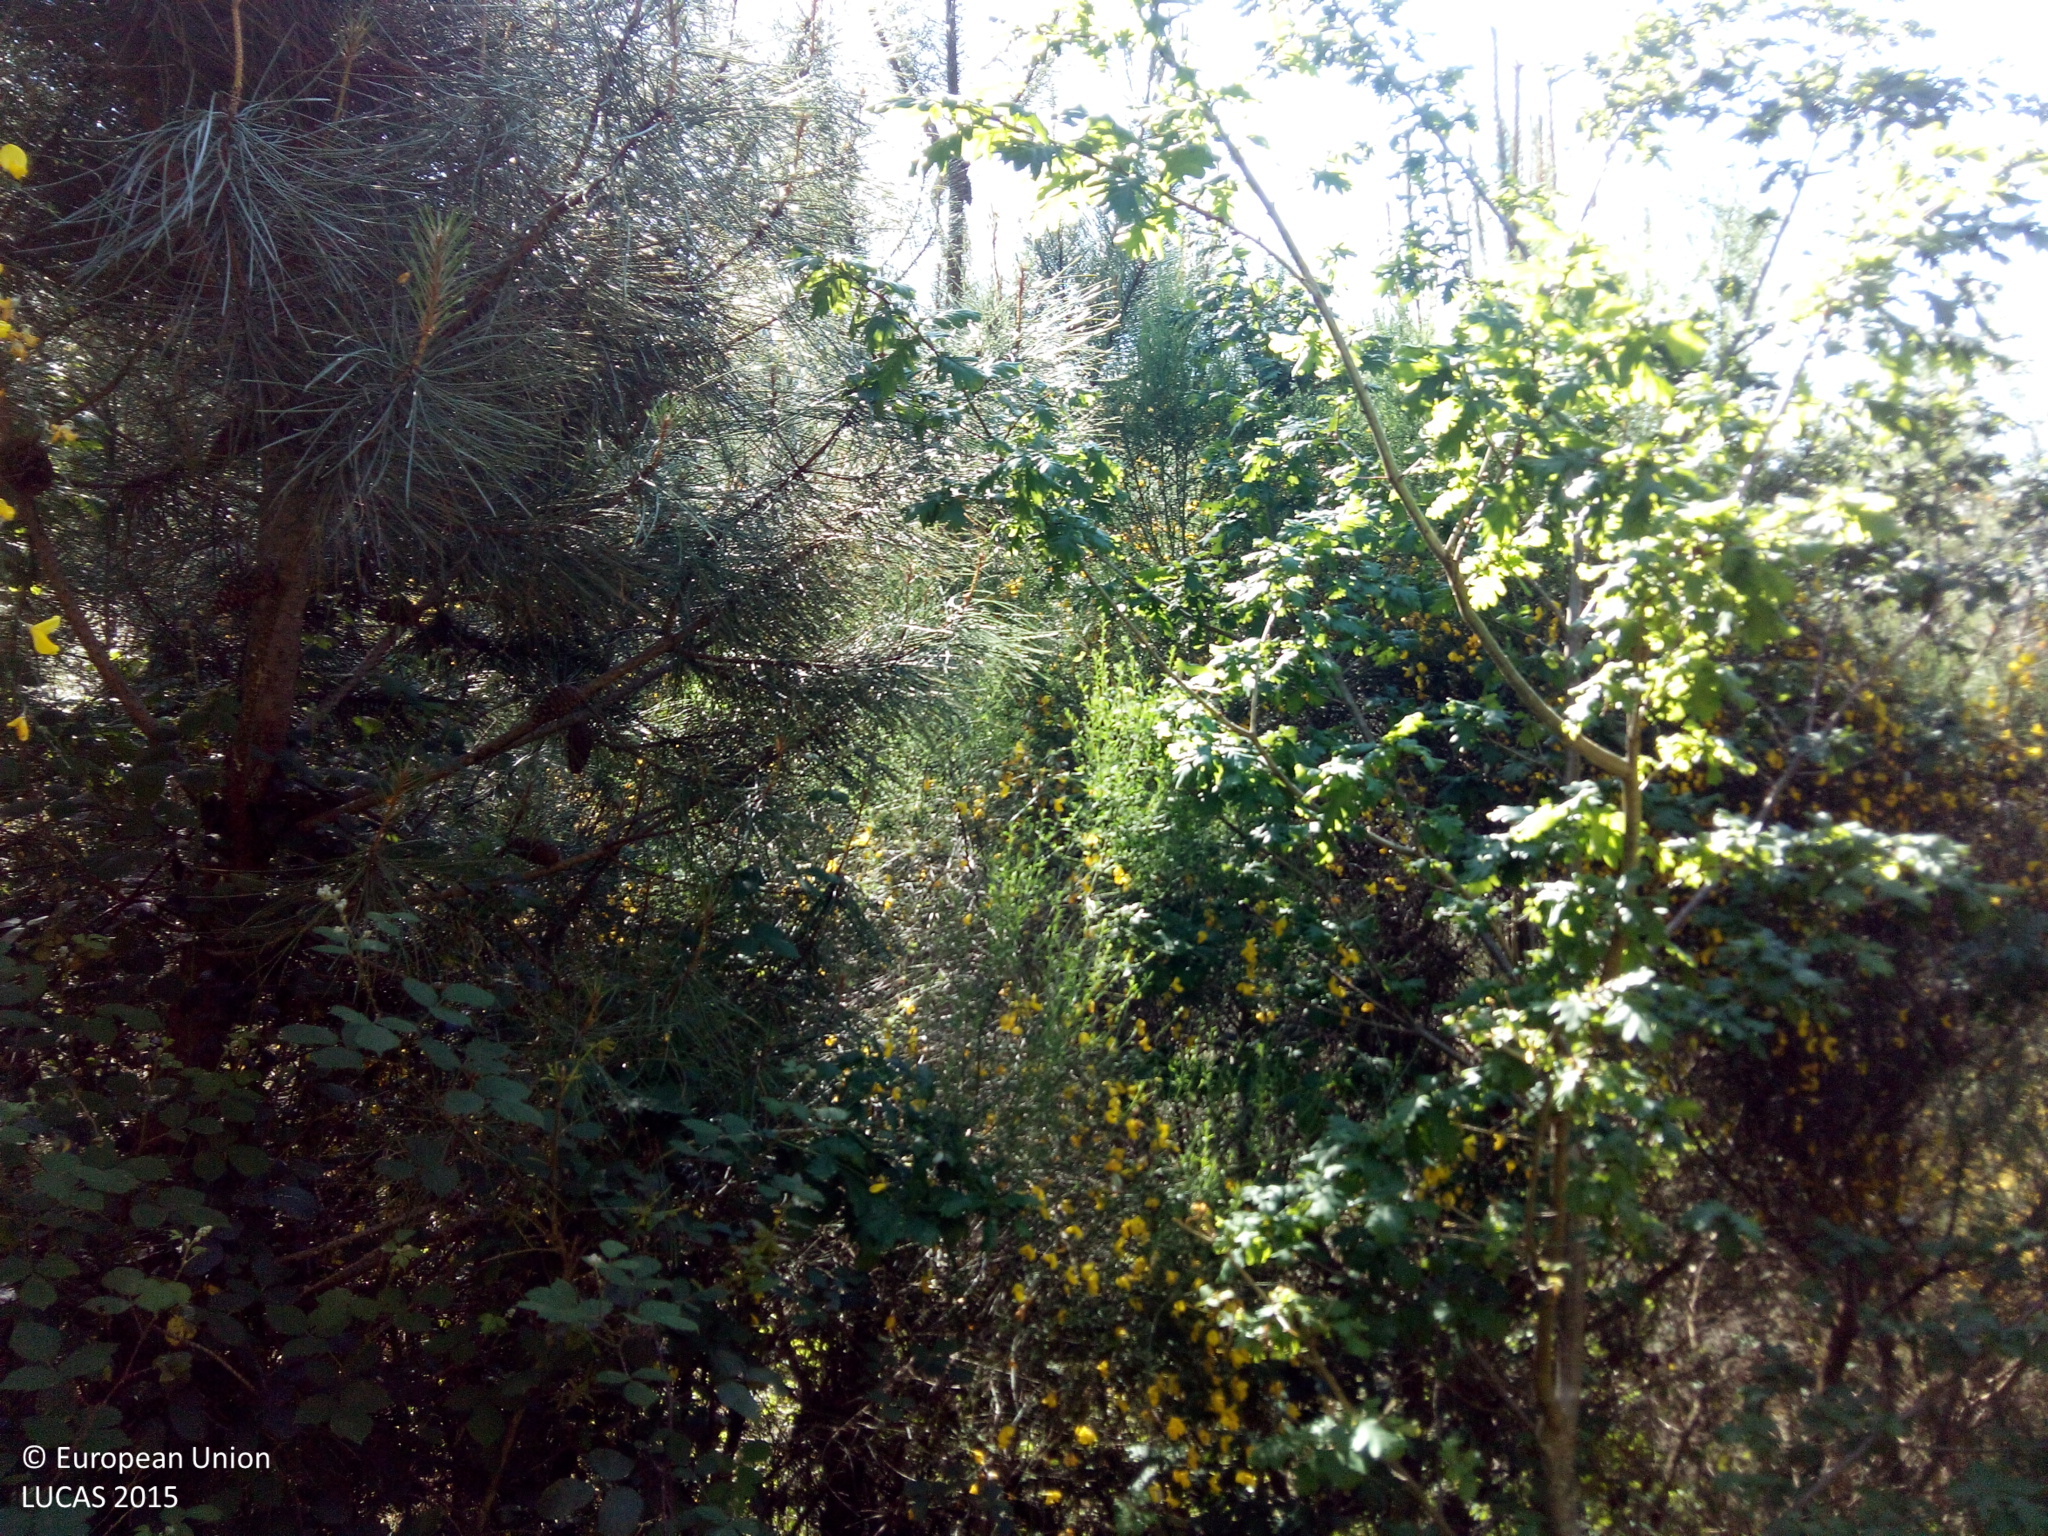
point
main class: Woodland
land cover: Pine dominated coniferous woodland
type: hemiboreal forest and nemoral coniferous forest and mixed broadleaved-coniferous forest
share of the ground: > 75 %
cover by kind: coniferous forest trees 100 %
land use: Forestry
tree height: > 5 m
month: May
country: ES
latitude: 42.0851
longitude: -8.8531
